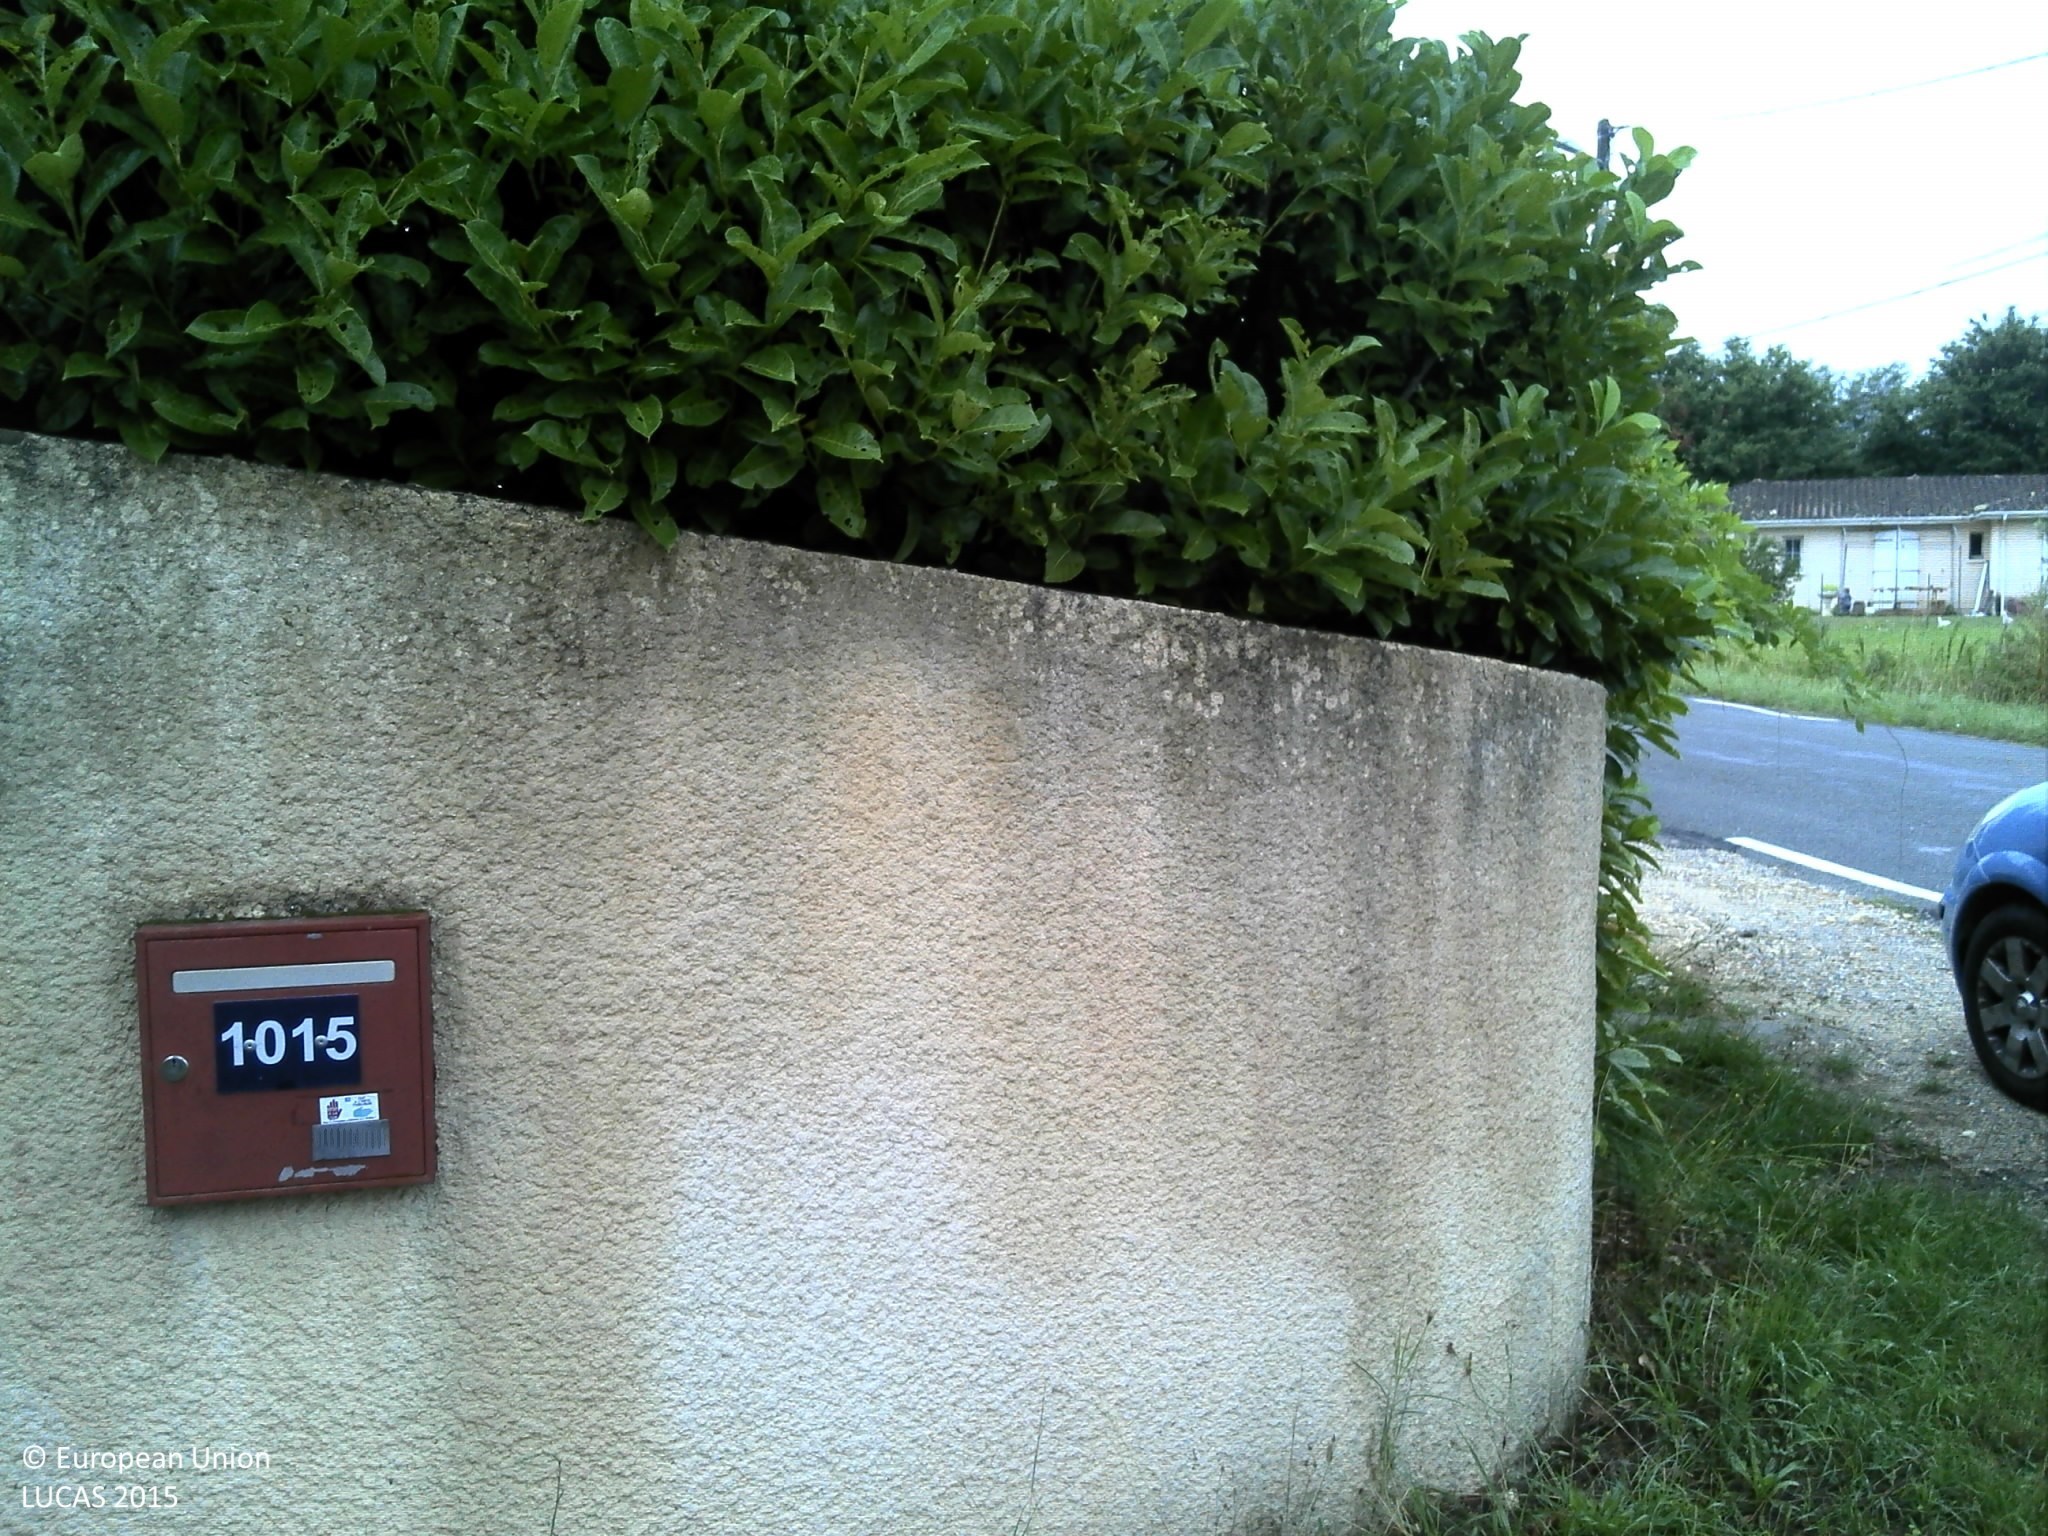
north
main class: Grassland
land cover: Grassland with sparse tree/shrub cover
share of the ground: > 75 %
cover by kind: herbaceous plants 95 %, broadleaved forest trees 5 %
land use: Residential
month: August
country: FR
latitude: 44.7342
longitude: -0.4089
